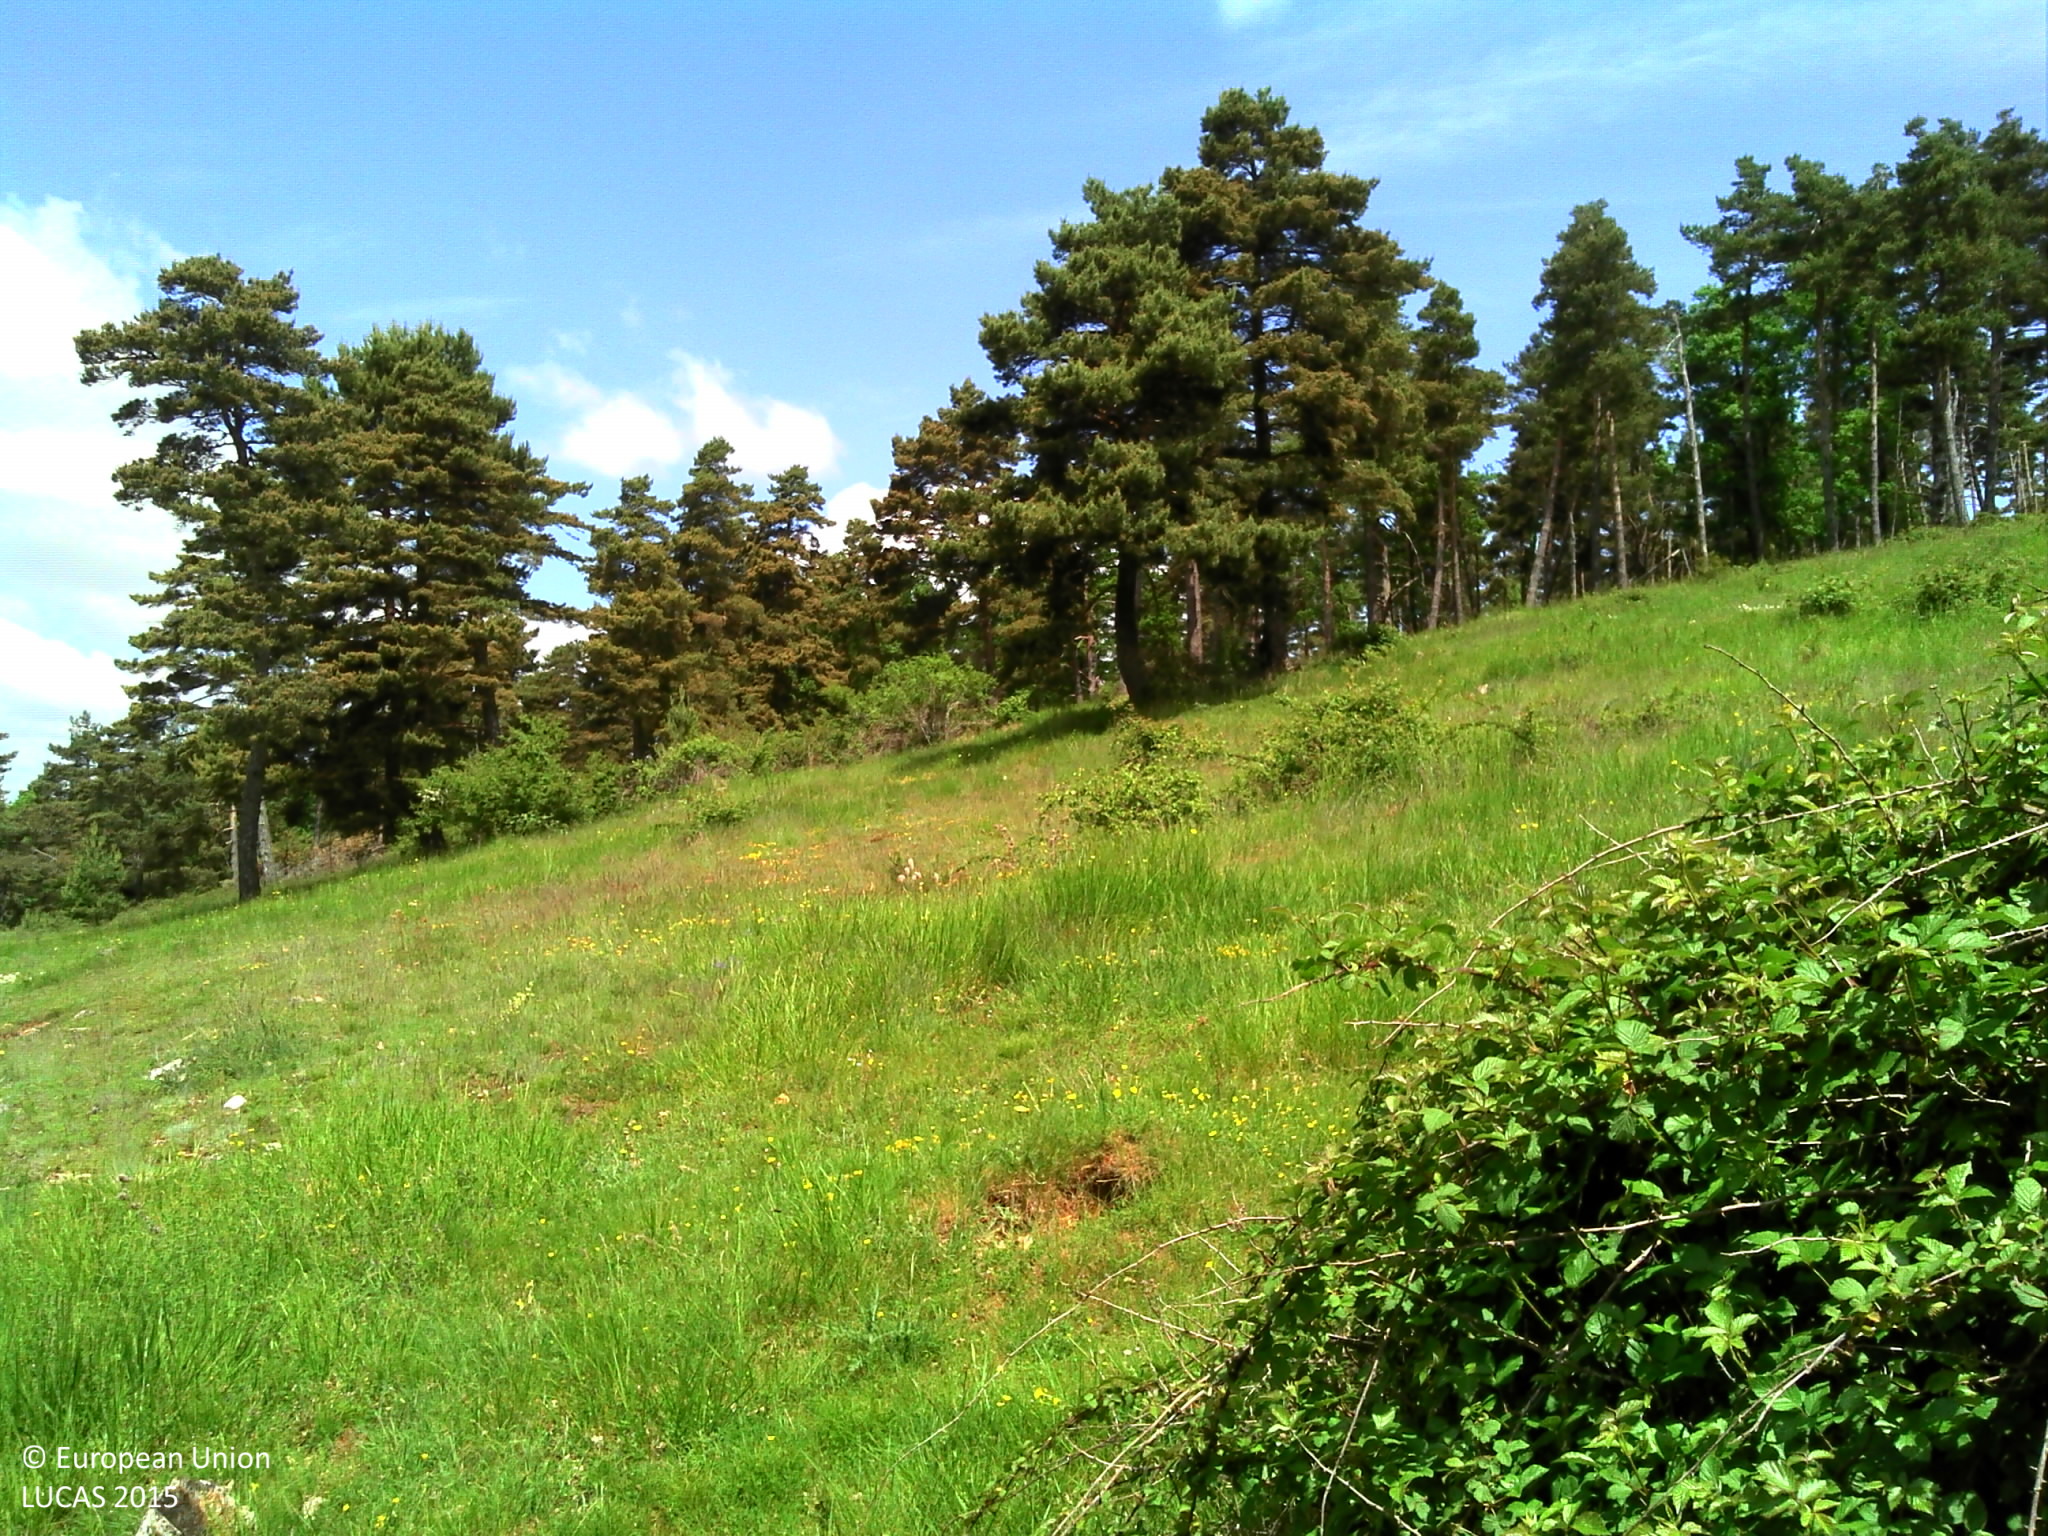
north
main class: Grassland
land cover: Grassland with sparse tree/shrub cover
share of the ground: > 75 %
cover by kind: herbaceous plants 90 %, broadleaved forest trees 5 %, shrubs 5 %
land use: Agriculture (excluding fallow land and kitchen gardens)
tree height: < 5 m
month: May
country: FR
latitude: 44.3880
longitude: 3.0377
